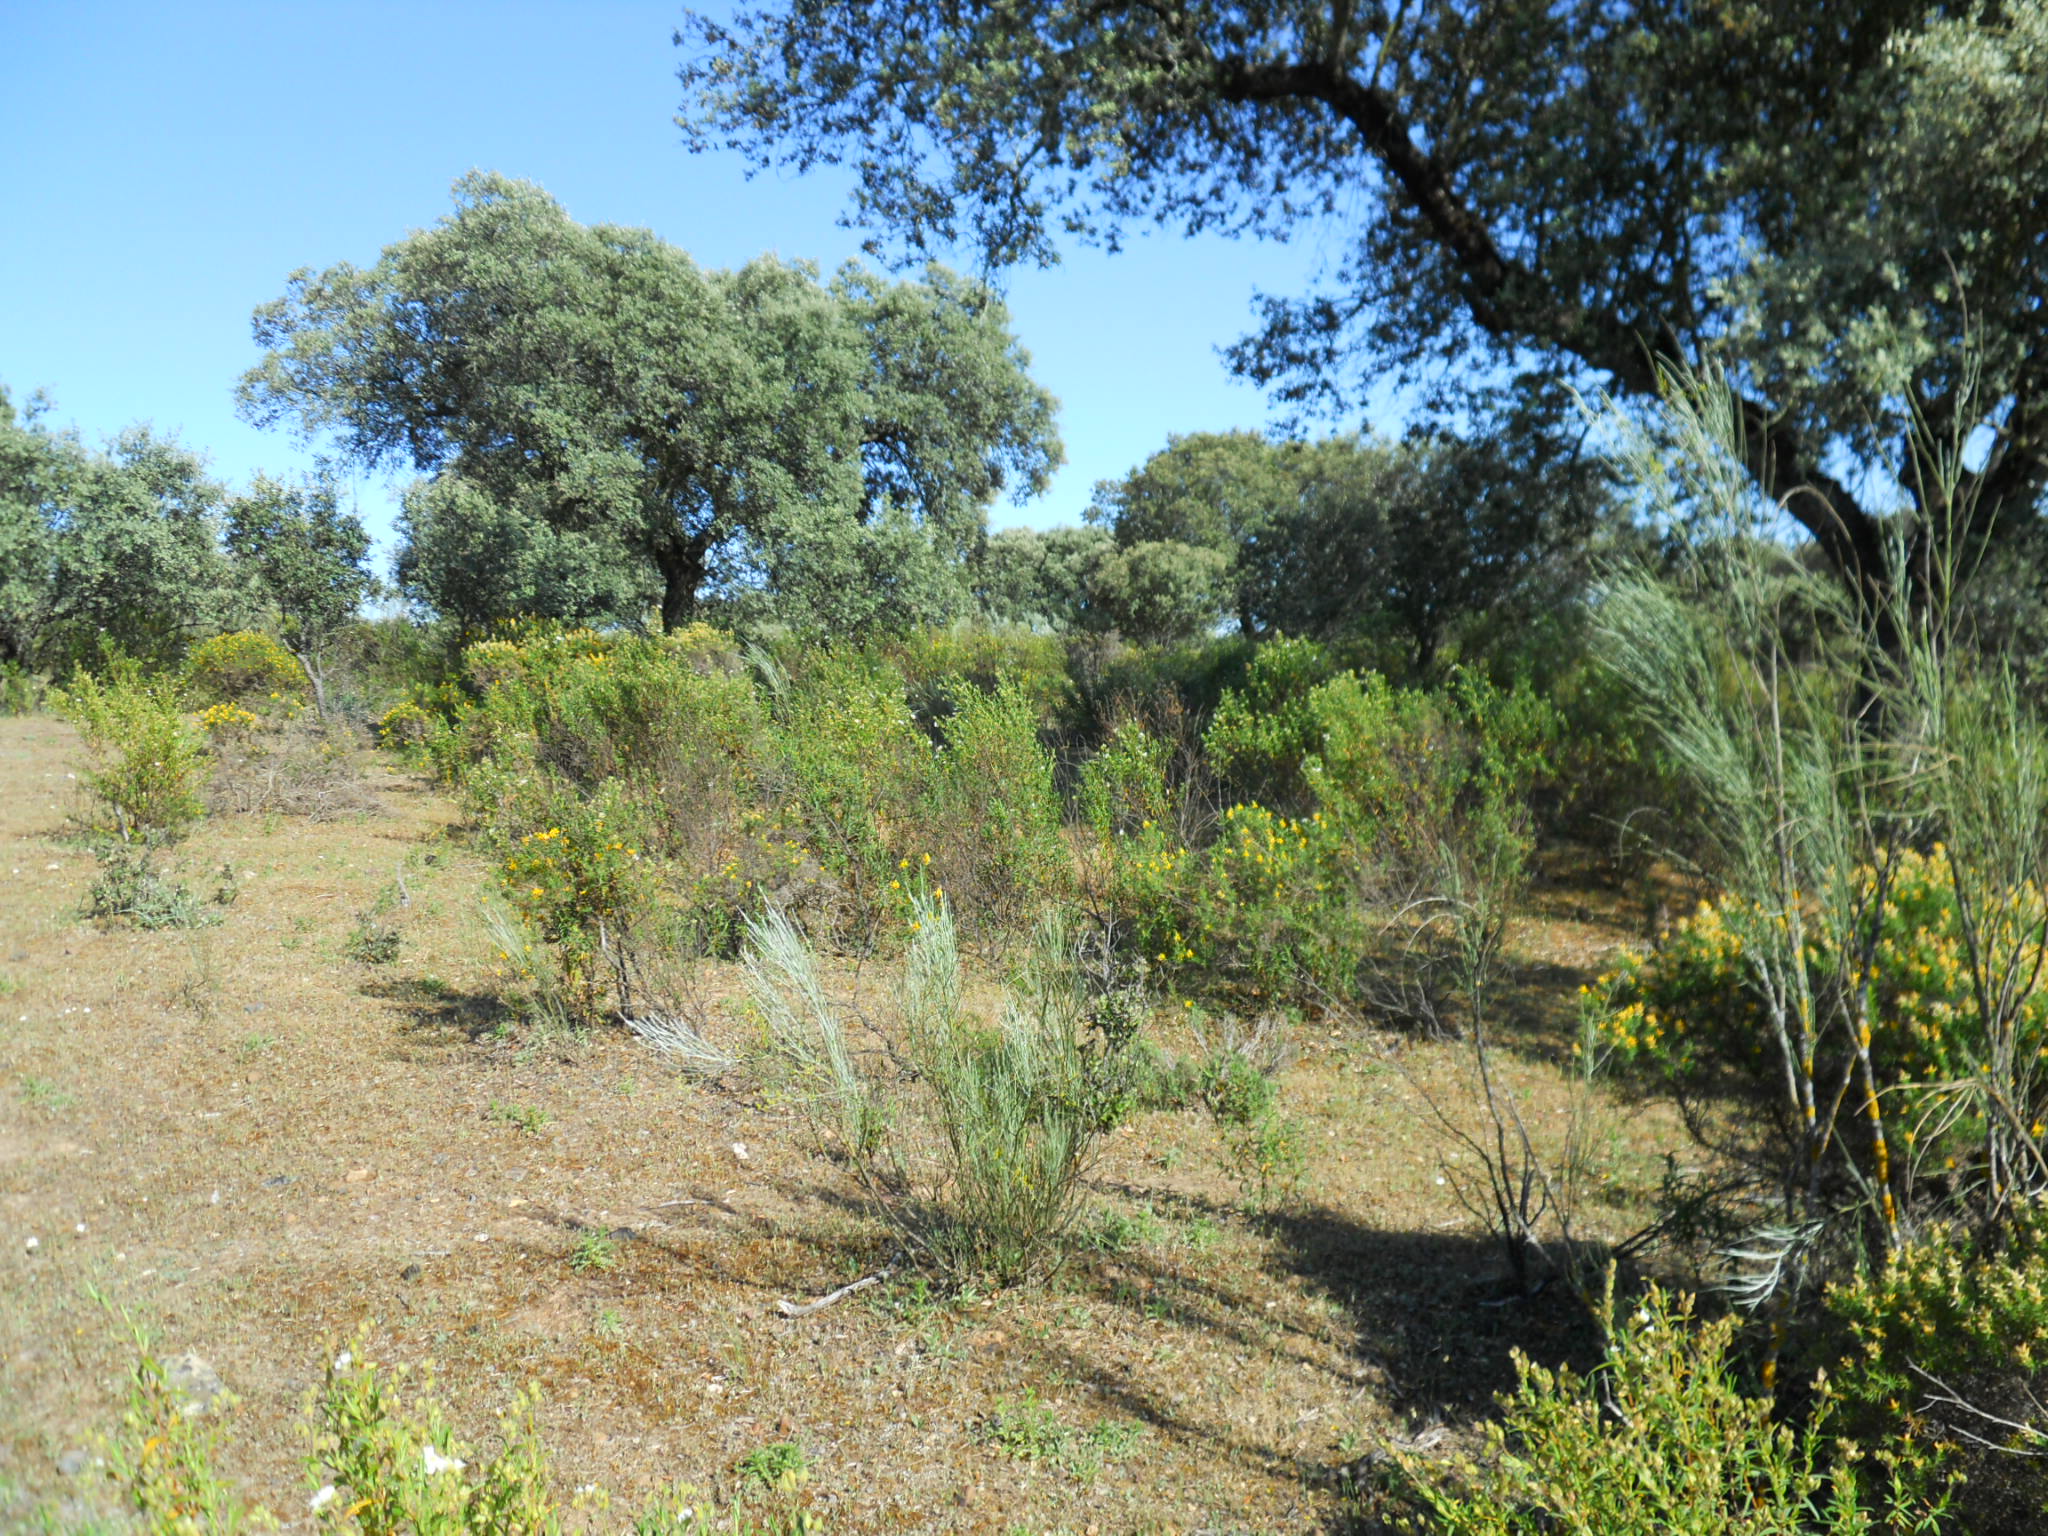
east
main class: Woodland
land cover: Broadleaved woodland
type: broadleaved evergreen forest
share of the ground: > 75 %
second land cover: Shrubland without tree cover
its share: > 75 %
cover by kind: broadleaved forest trees 80 %, shrubs 15 %, herbaceous plants 5 %
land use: Forestry
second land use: Agriculture (excluding fallow land and kitchen gardens)
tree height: > 5 m
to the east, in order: Broadleaved woodland; Shrubland without tree cover
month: May
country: ES
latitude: 39.0391
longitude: -6.5266
